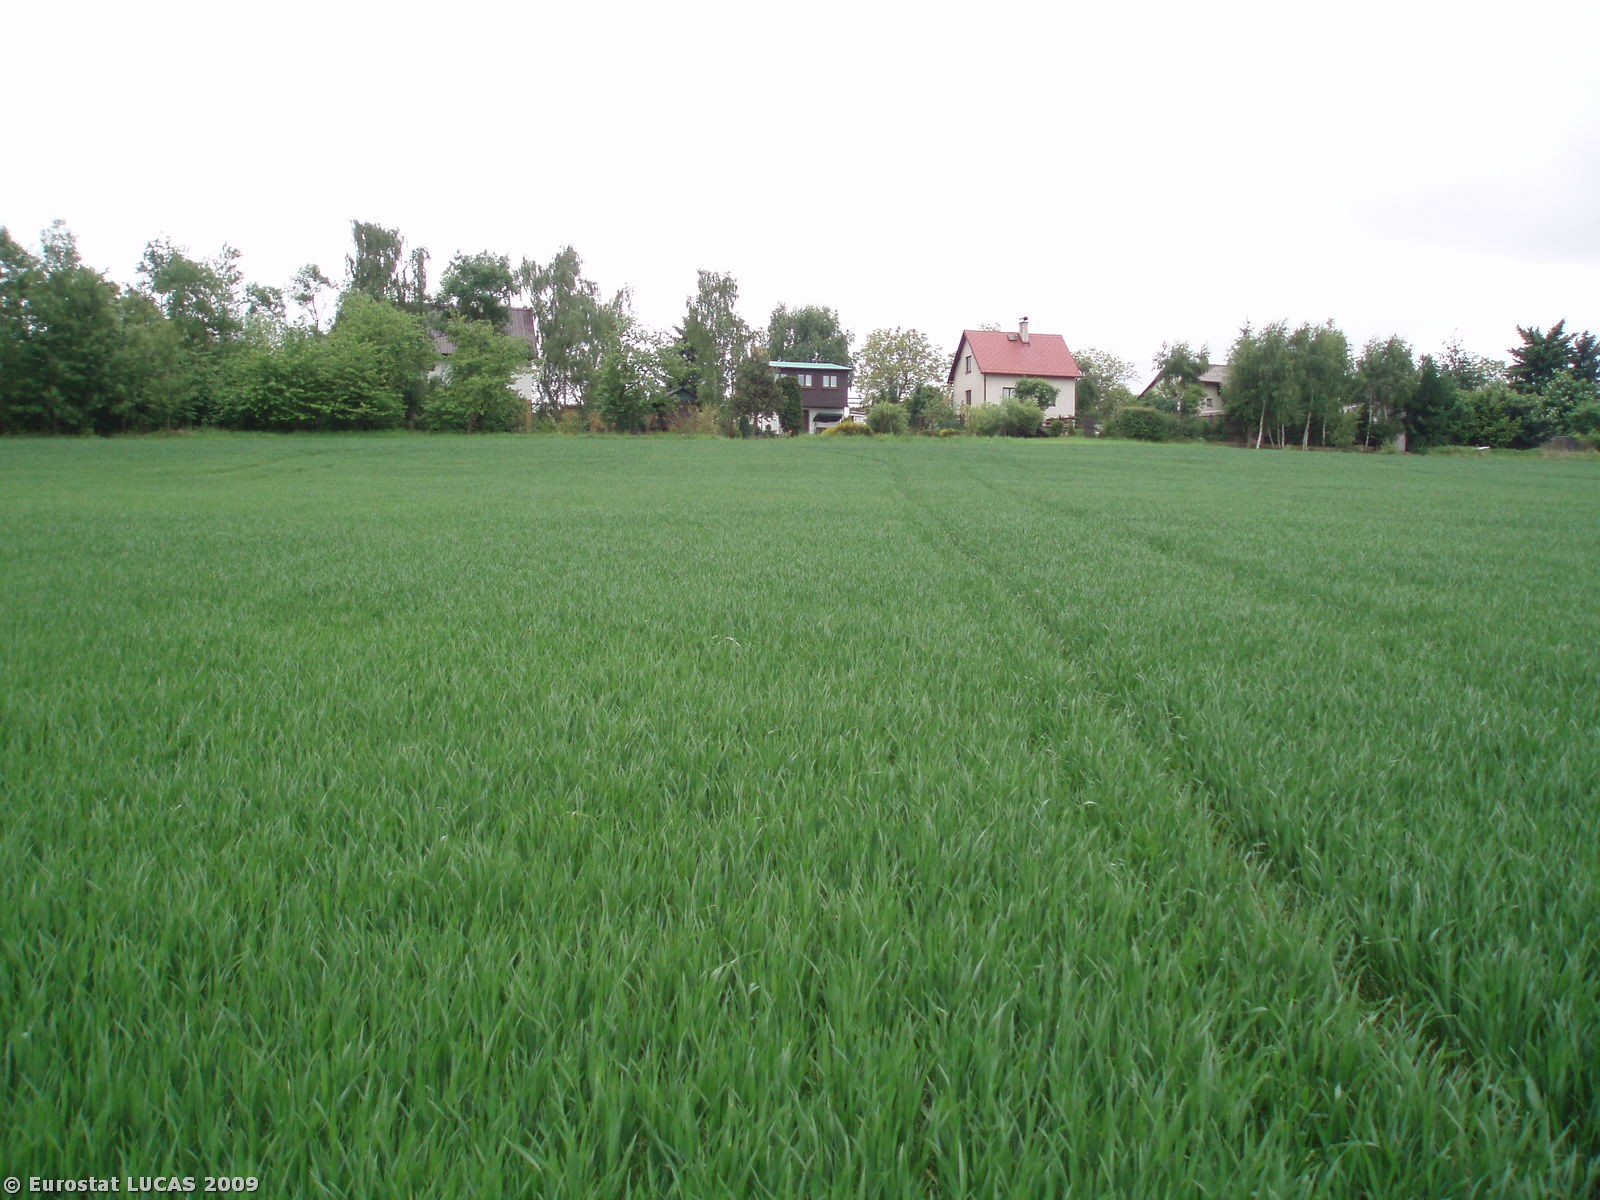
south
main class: Cropland
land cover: Common wheat
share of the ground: > 75 %
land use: Agriculture (excluding fallow land and kitchen gardens)
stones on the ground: < 10 %
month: May
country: CZ
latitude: 50.0547
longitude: 14.1493
